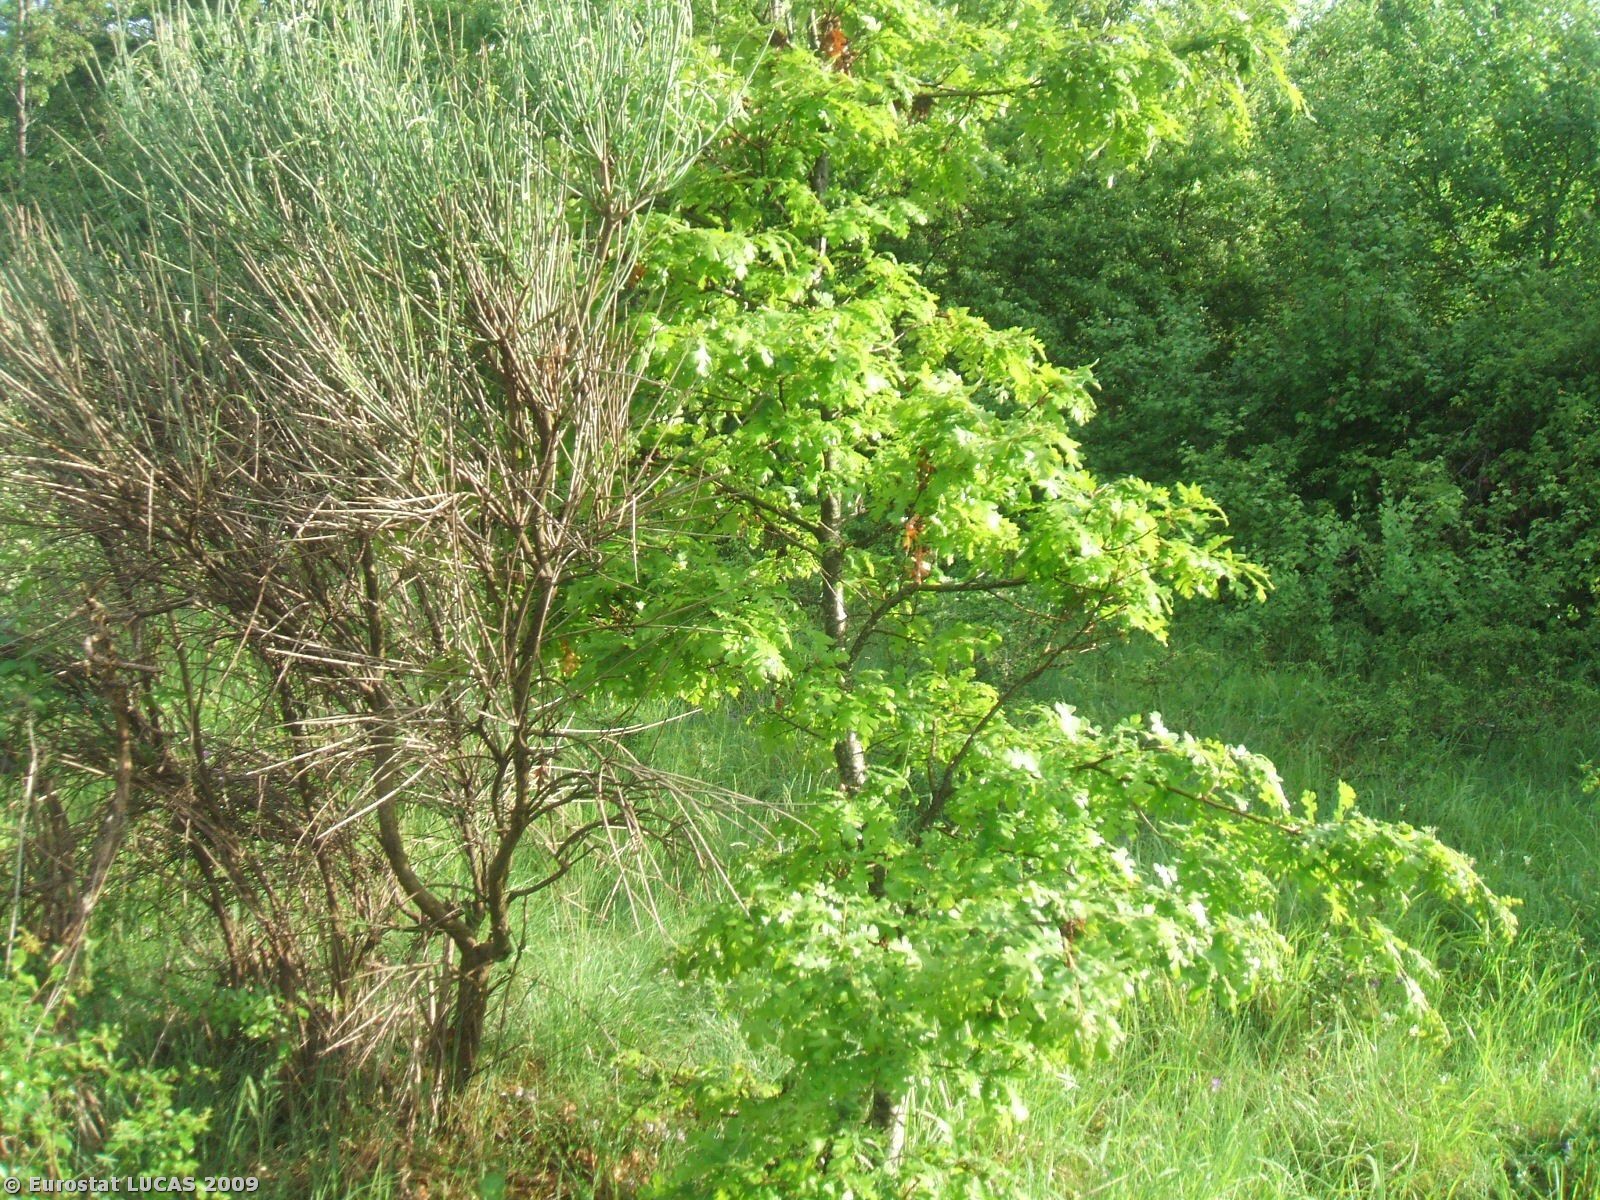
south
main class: Shrubland
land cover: Shrubland with sparse tree cover
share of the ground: > 75 %
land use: Fallow land
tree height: < 5 m
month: May
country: IT
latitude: 40.2772
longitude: 15.7975
